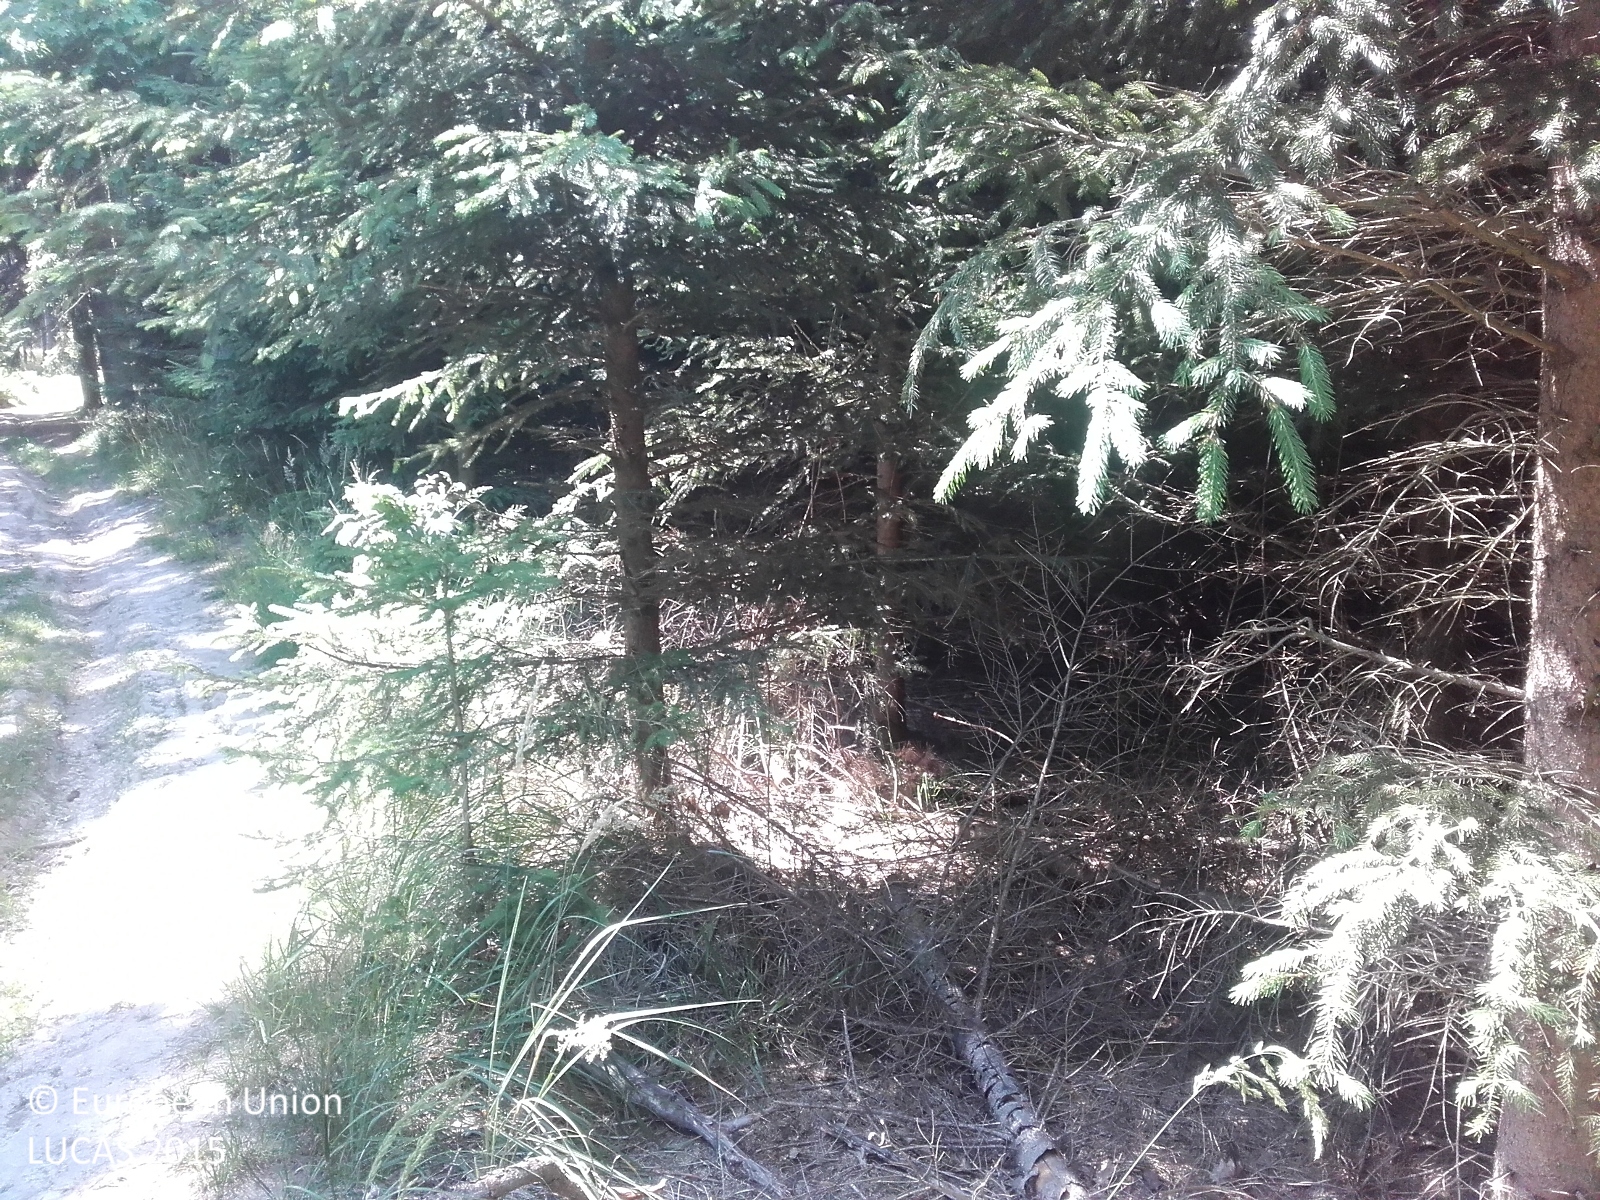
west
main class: Woodland
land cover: Spruce dominated coniferous woodland
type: hemiboreal forest and nemoral coniferous forest and mixed broadleaved-coniferous forest
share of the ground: > 75 %
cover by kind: coniferous forest trees 95 %, herbaceous plants 5 %
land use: Forestry
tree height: > 5 m
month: July
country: CZ
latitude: 49.5493
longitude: 17.0728
